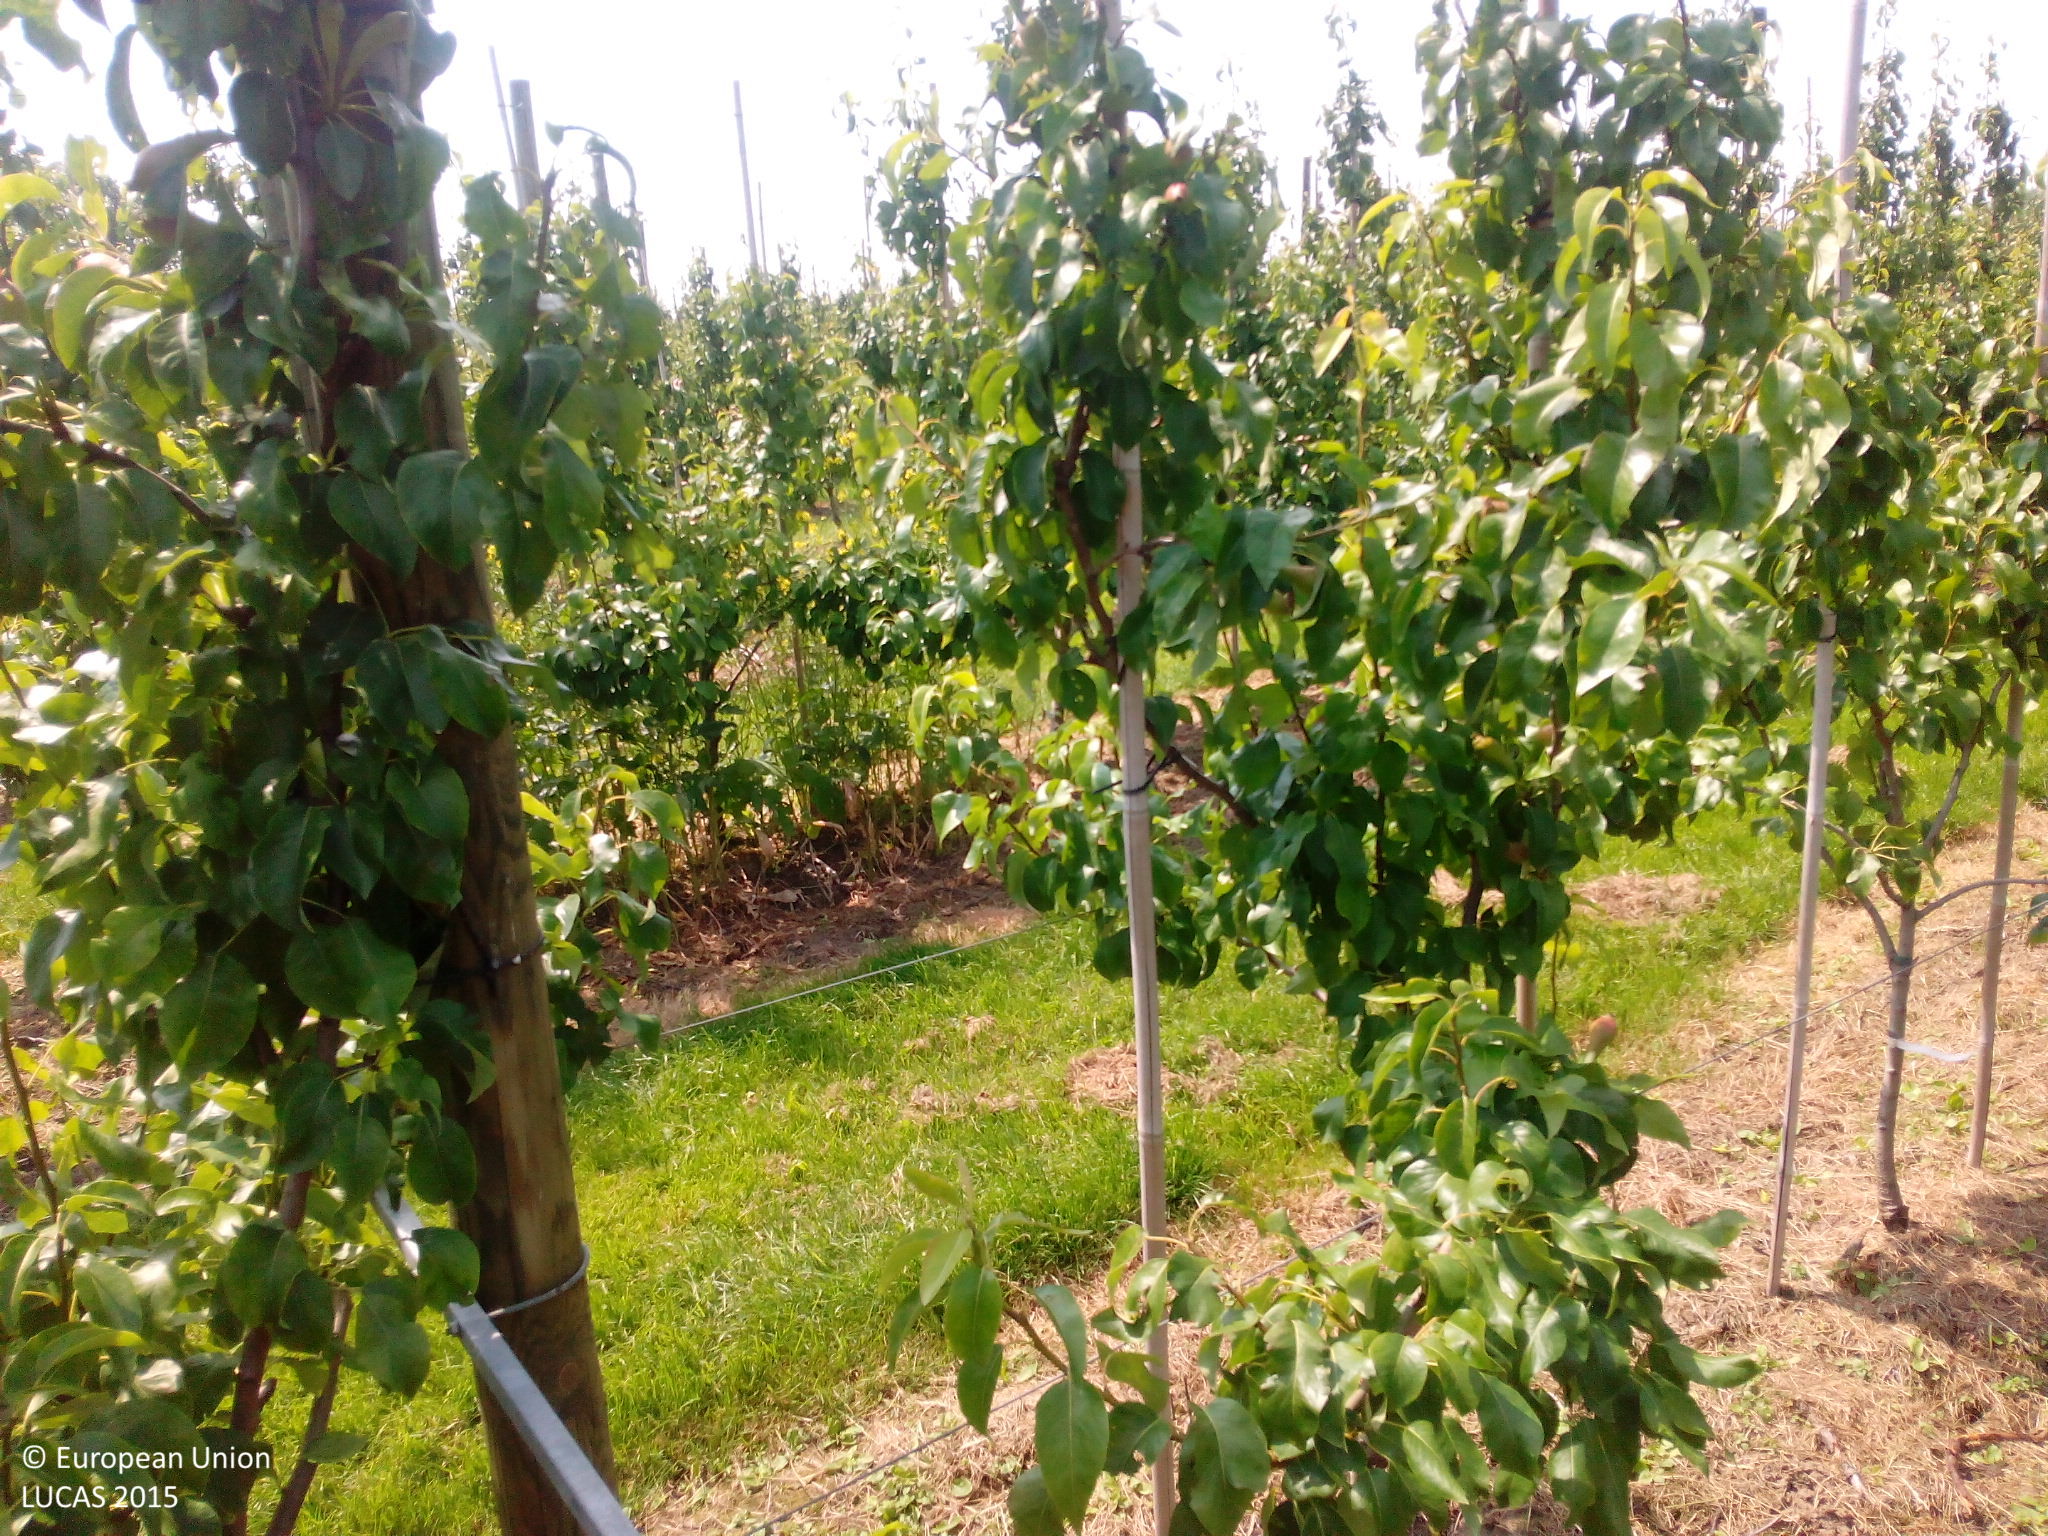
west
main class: Cropland
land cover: Pear fruit
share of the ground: 50 - 75 %
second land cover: Grassland without tree/shrub cover
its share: 25 - 50 %
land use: Agriculture (excluding fallow land and kitchen gardens)
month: June
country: NL
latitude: 51.6642
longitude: 4.6904
